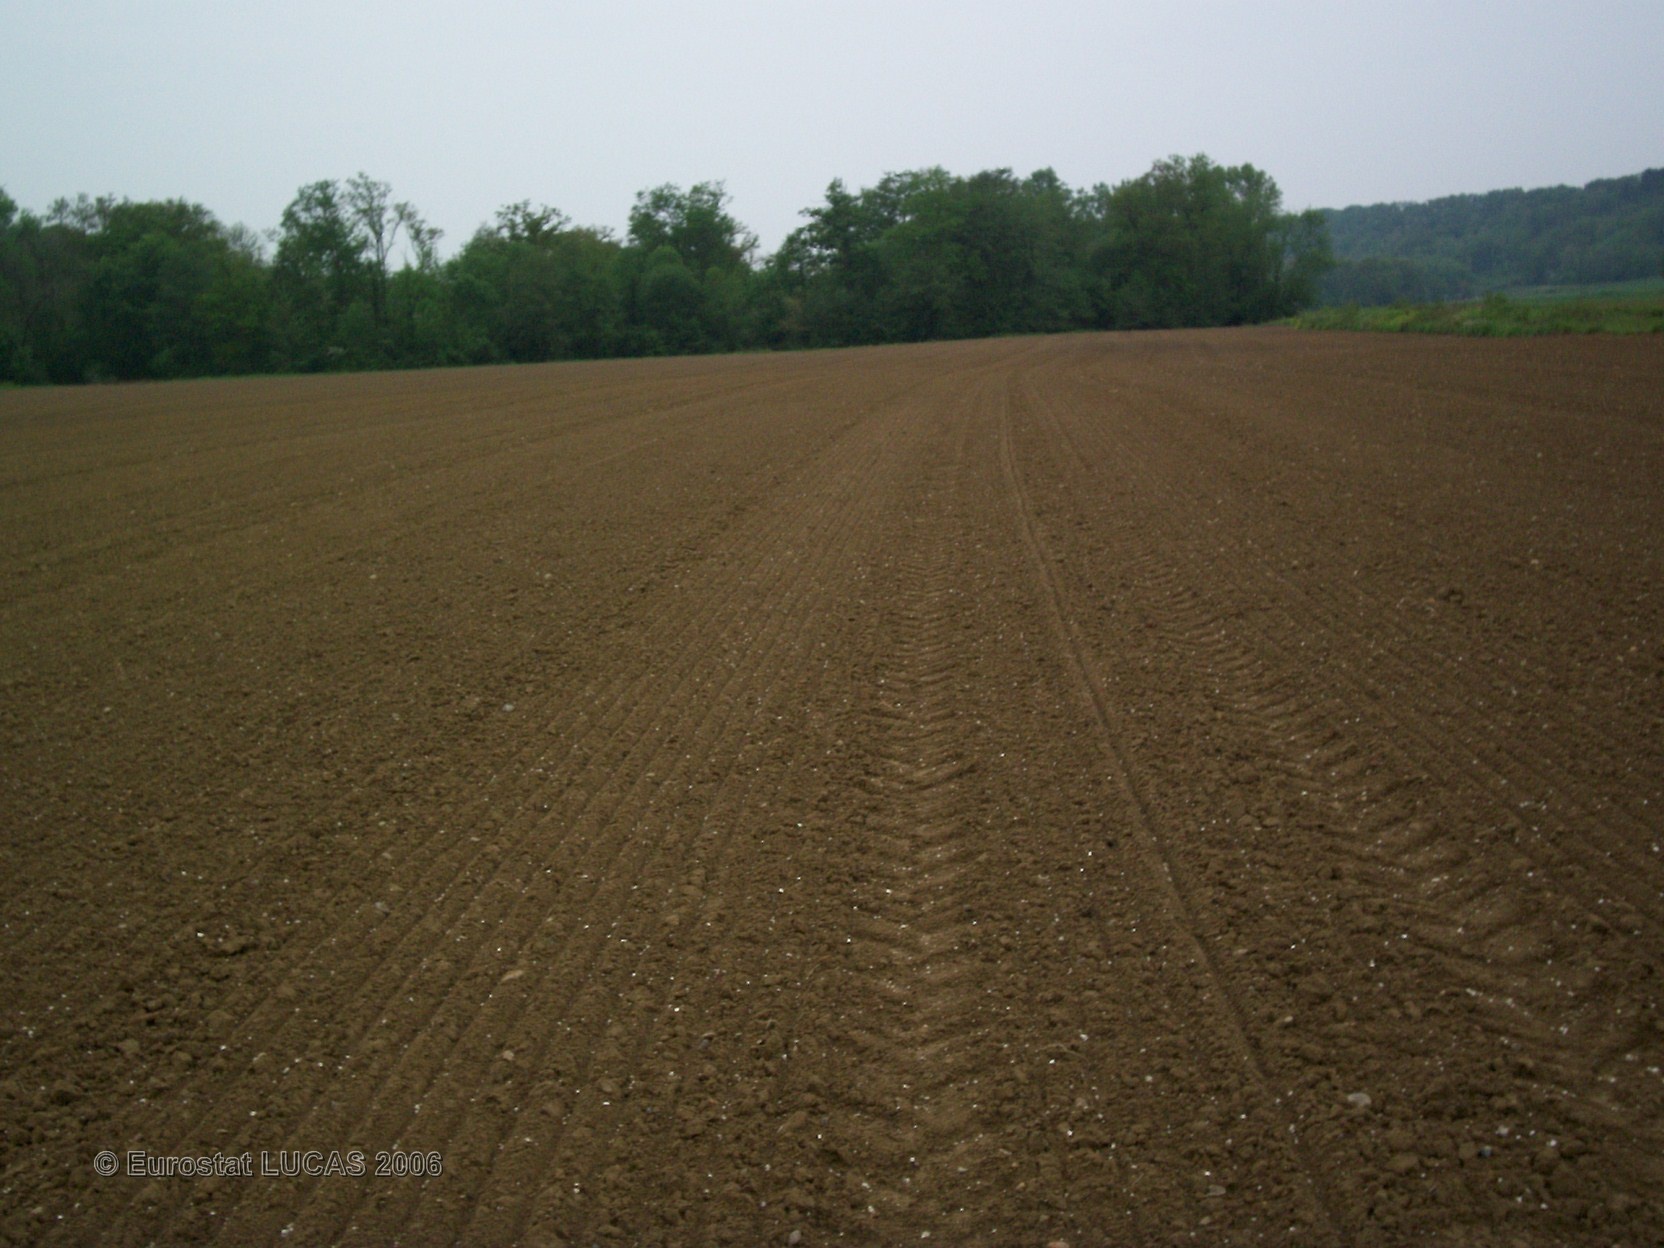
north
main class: Cropland
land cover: Maize
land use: Agriculture (excluding fallow land and kitchen gardens)
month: June
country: FR
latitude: 43.6845
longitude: -0.3678
